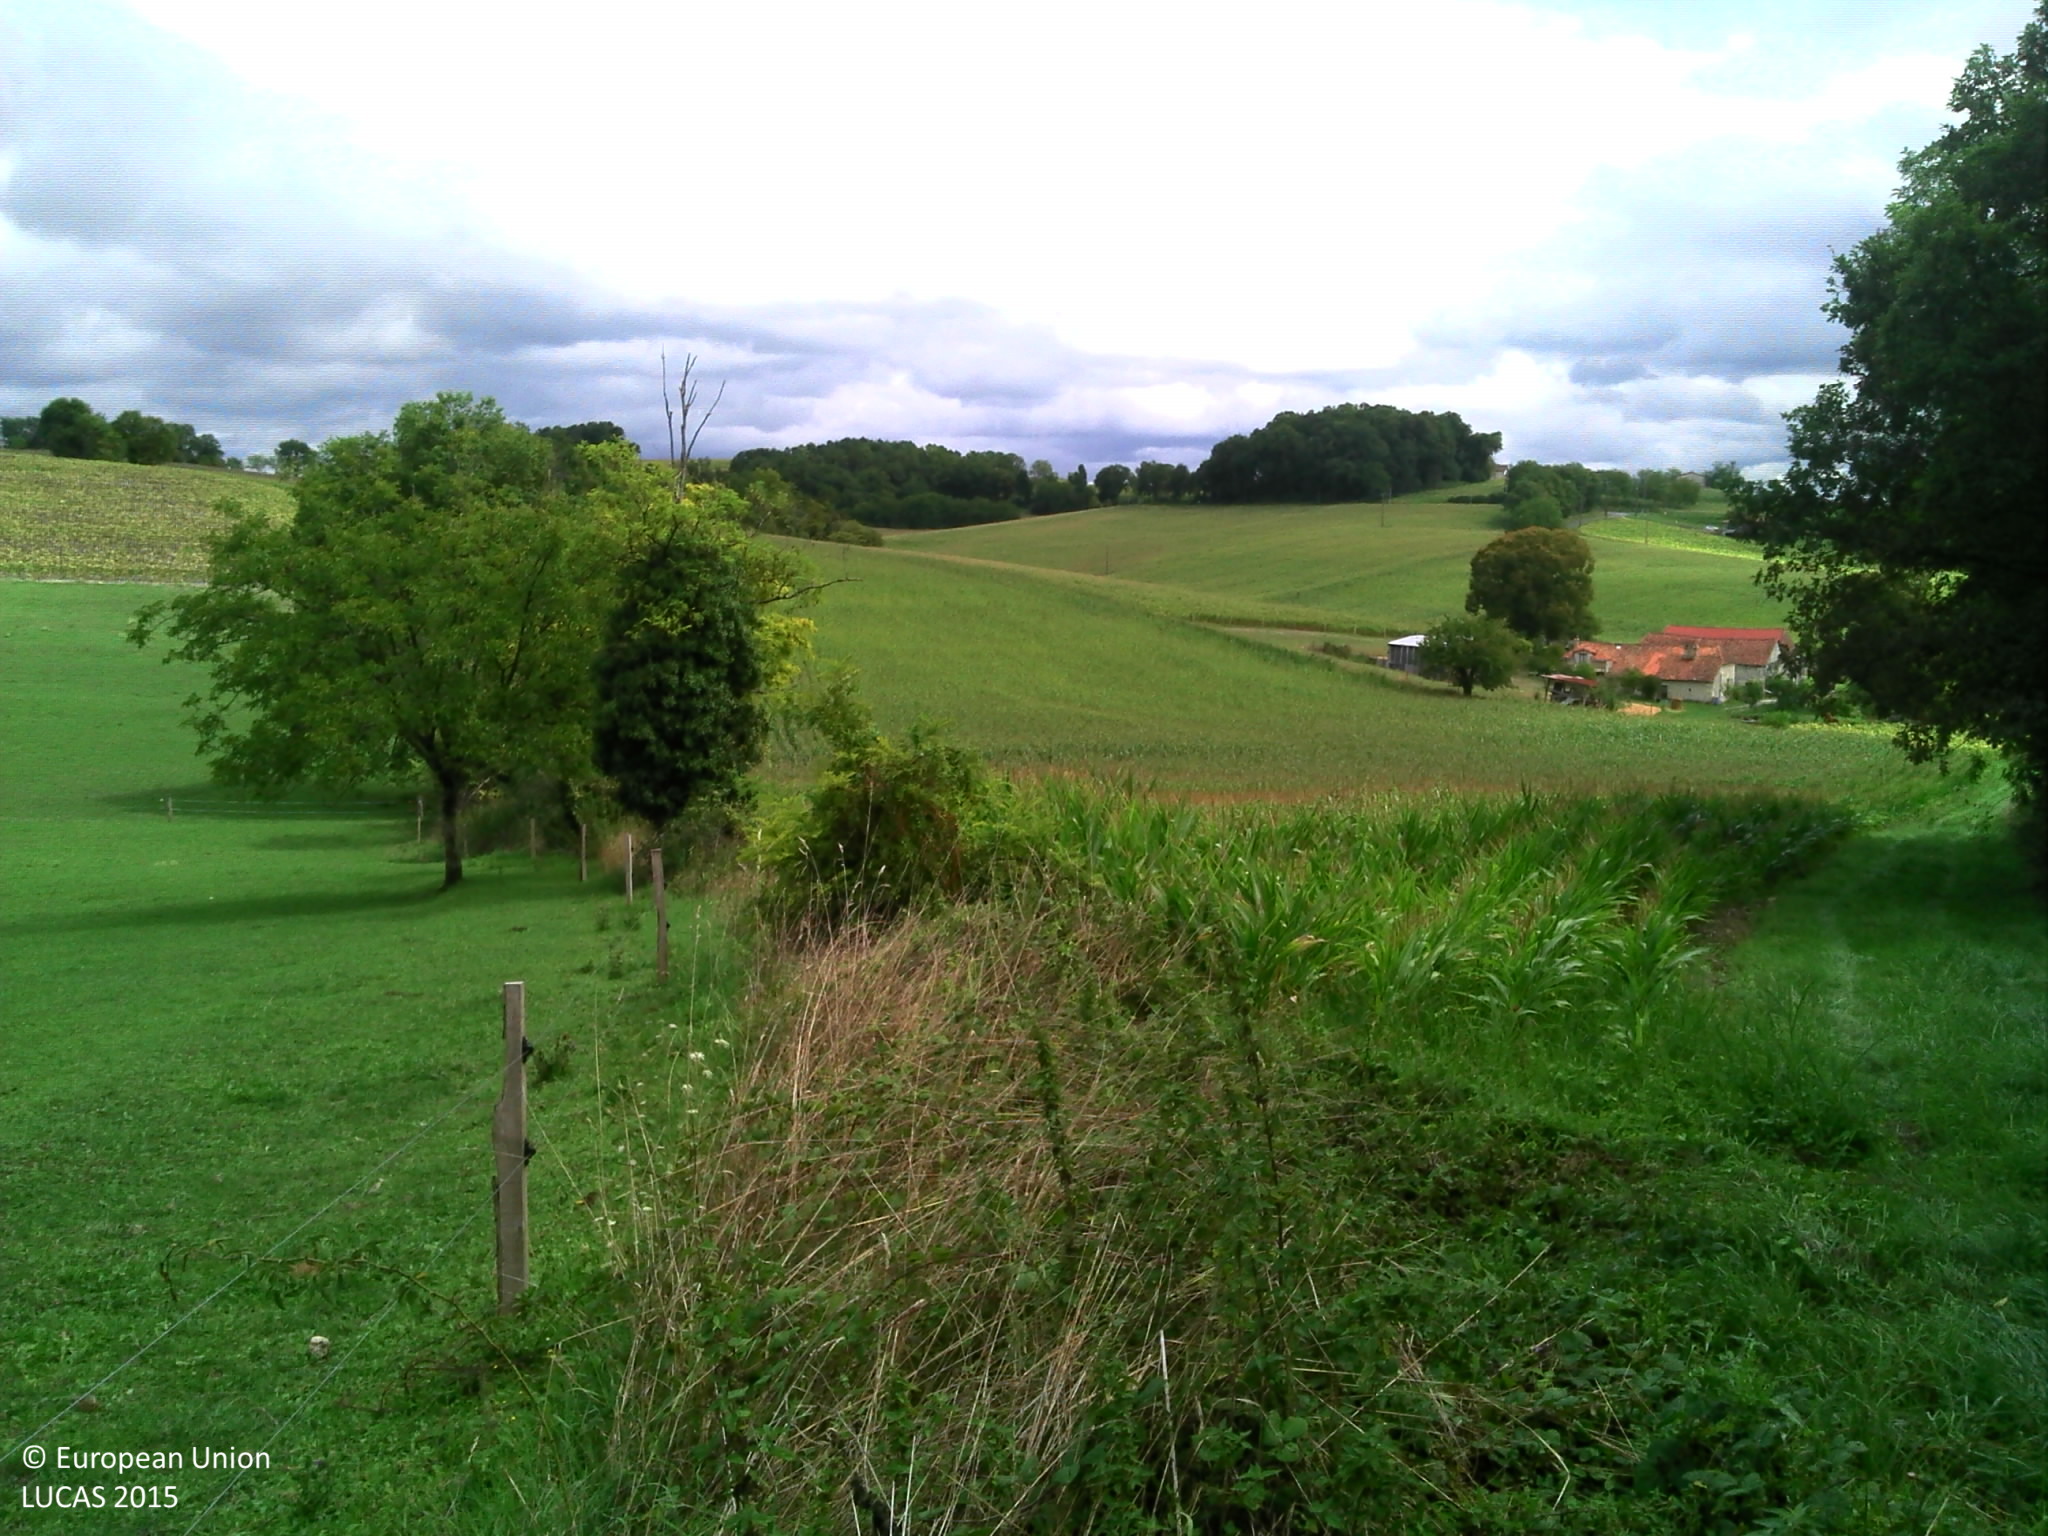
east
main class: Grassland
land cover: Grassland without tree/shrub cover
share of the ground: > 75 %
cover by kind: herbaceous plants 80 %, lichens and mosses 20 %
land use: Agriculture (excluding fallow land and kitchen gardens)
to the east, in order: Grassland without tree/shrub cover; Fences; Grassland without tree/shrub cover; Fences; Abandoned hedges; Spontaneously vegetated surfaces; Maize
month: August
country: FR
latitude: 45.2918
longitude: 0.4887
